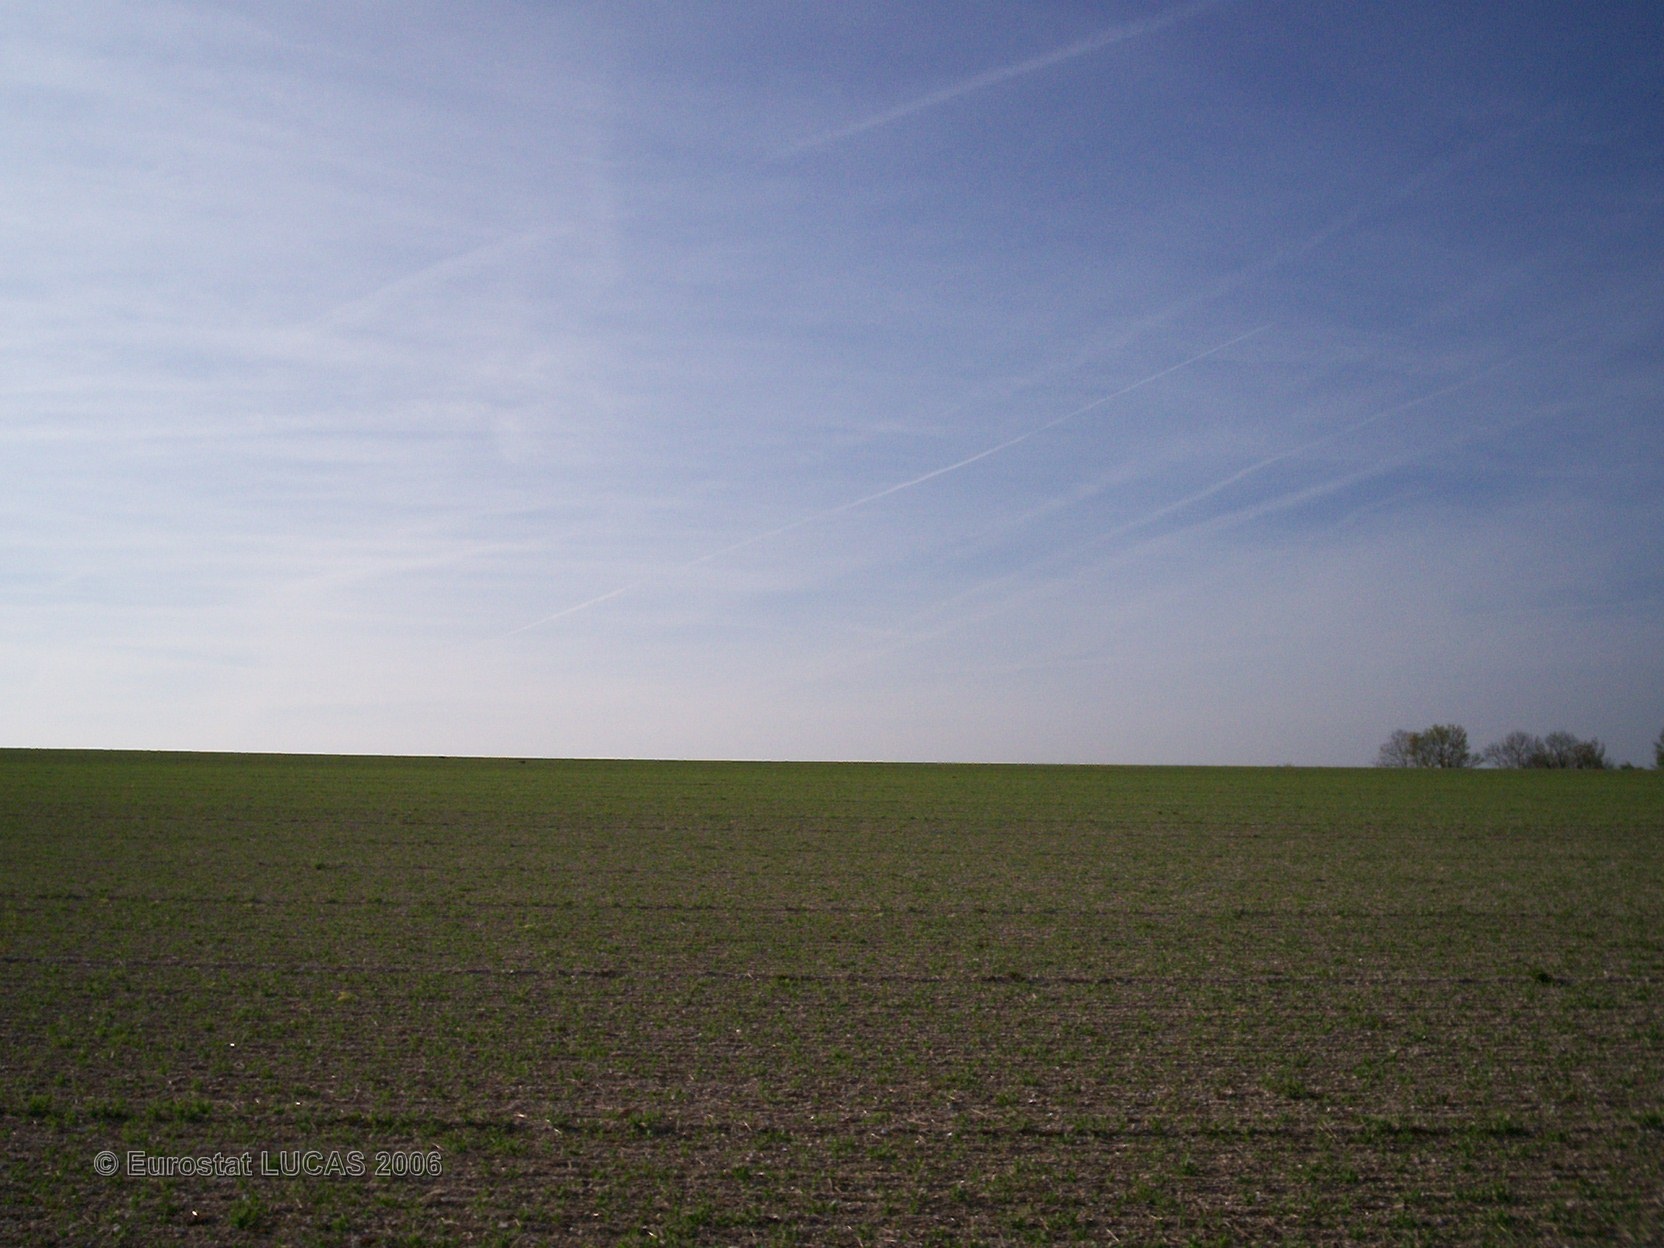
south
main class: Cropland
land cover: Dry pulses
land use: Agriculture (excluding fallow land and kitchen gardens)
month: May
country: FR
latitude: 48.7848
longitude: 4.4028
